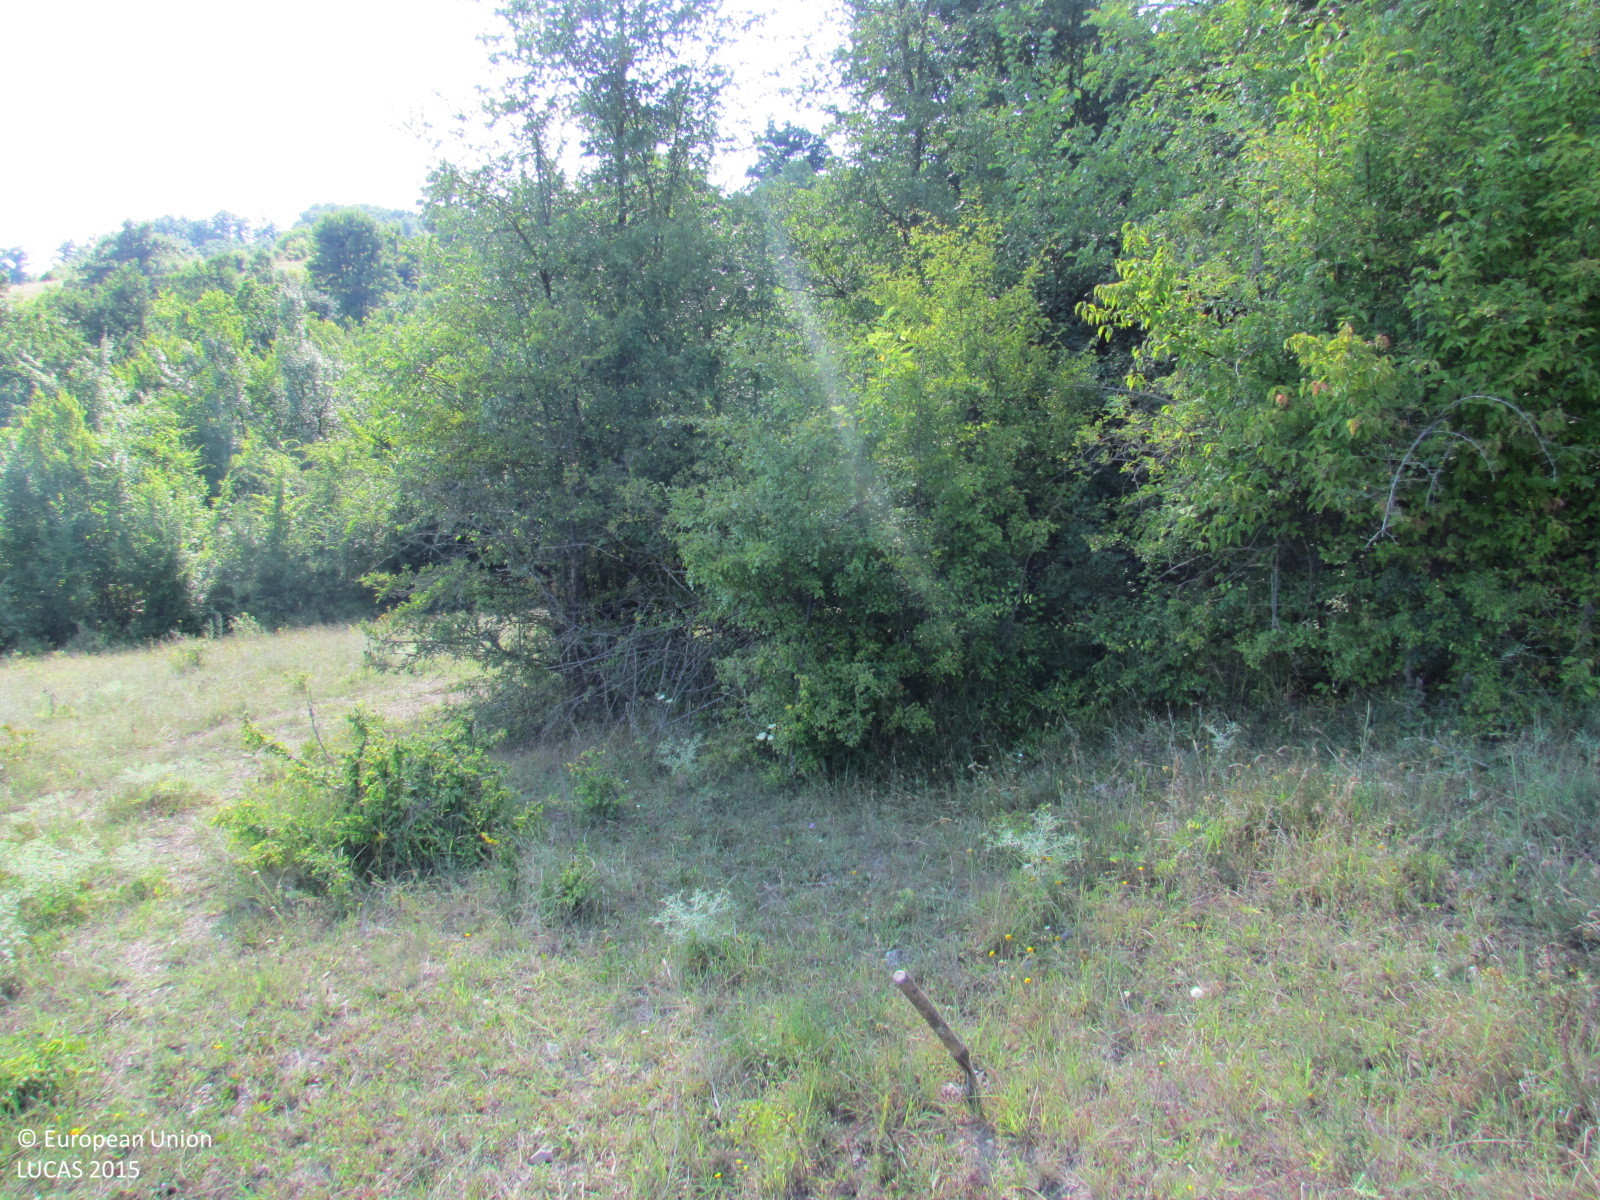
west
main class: Grassland
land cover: Grassland with sparse tree/shrub cover
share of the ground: > 75 %
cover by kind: herbaceous plants 90 %, broadleaved forest trees 5 %, shrubs 5 %
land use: Agriculture (excluding fallow land and kitchen gardens)
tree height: > 5 m
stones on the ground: < 10 %
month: July
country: BG
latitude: 42.8990
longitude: 27.4258
